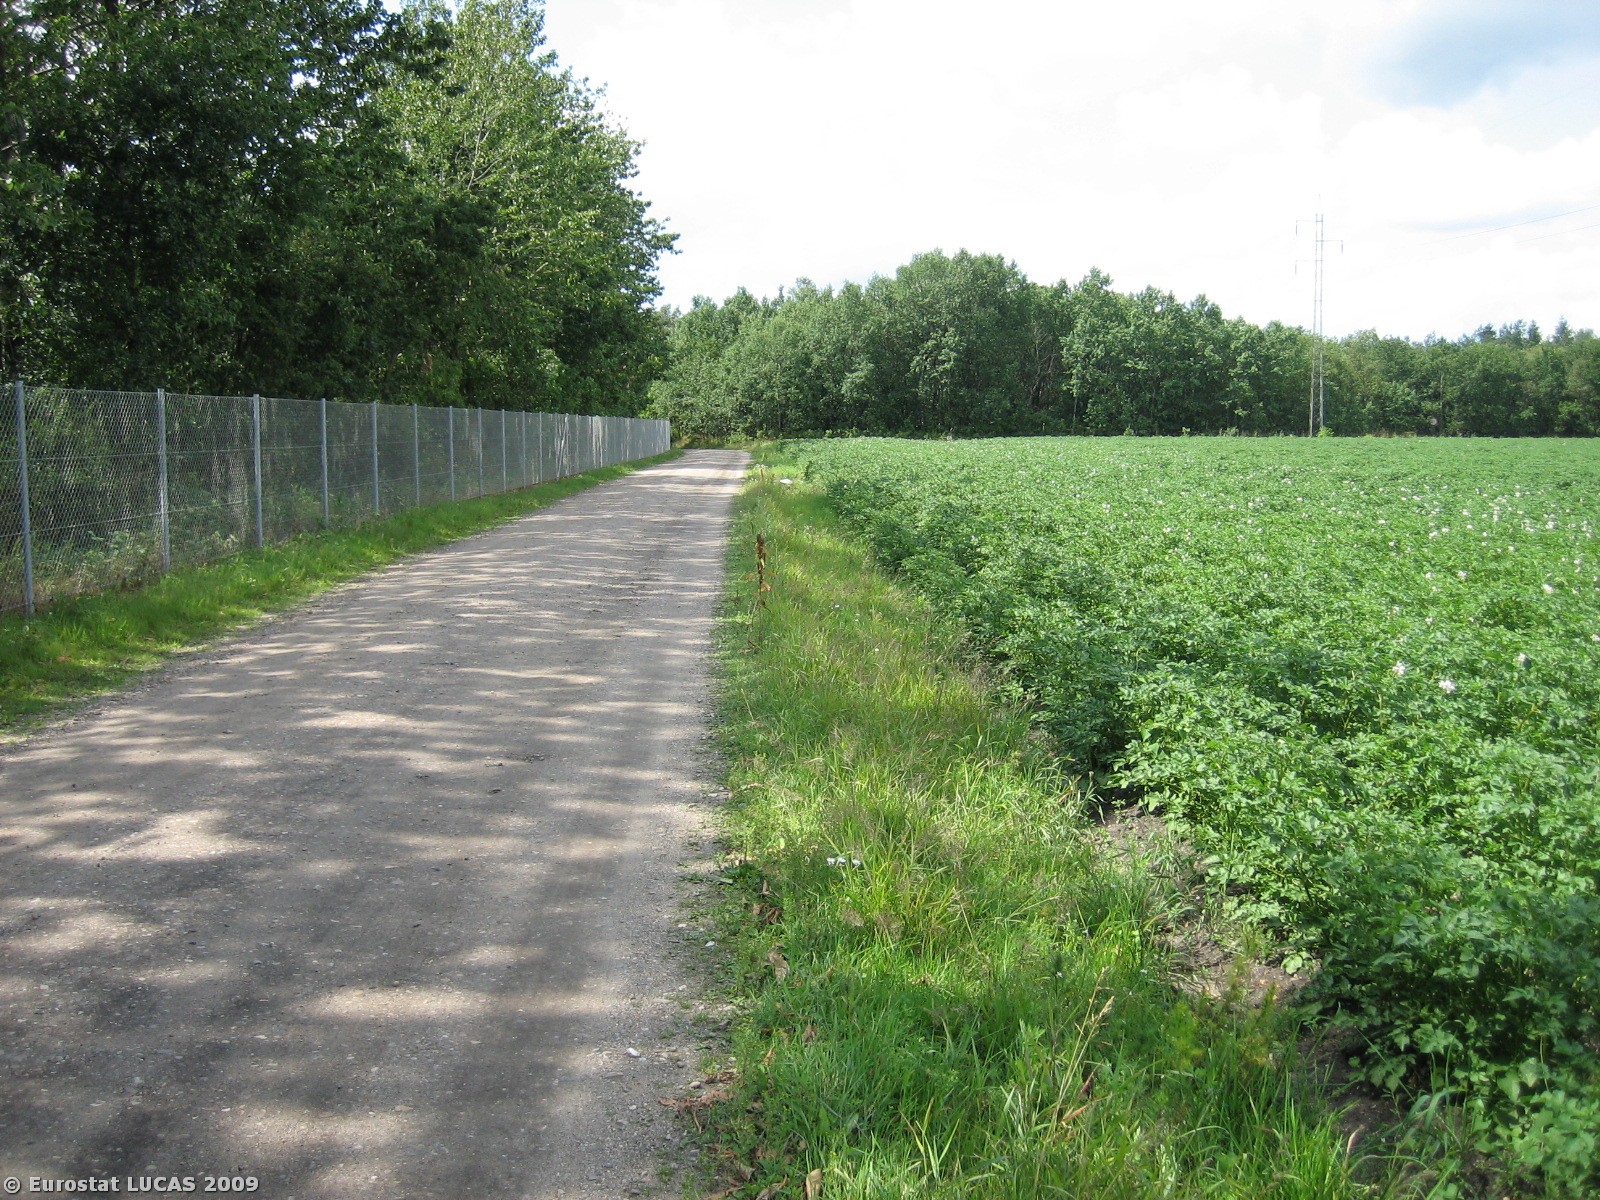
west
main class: Cropland
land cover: Potatoes
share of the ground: > 75 %
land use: Agriculture (excluding fallow land and kitchen gardens)
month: July
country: DK
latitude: 55.7698
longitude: 8.9331
